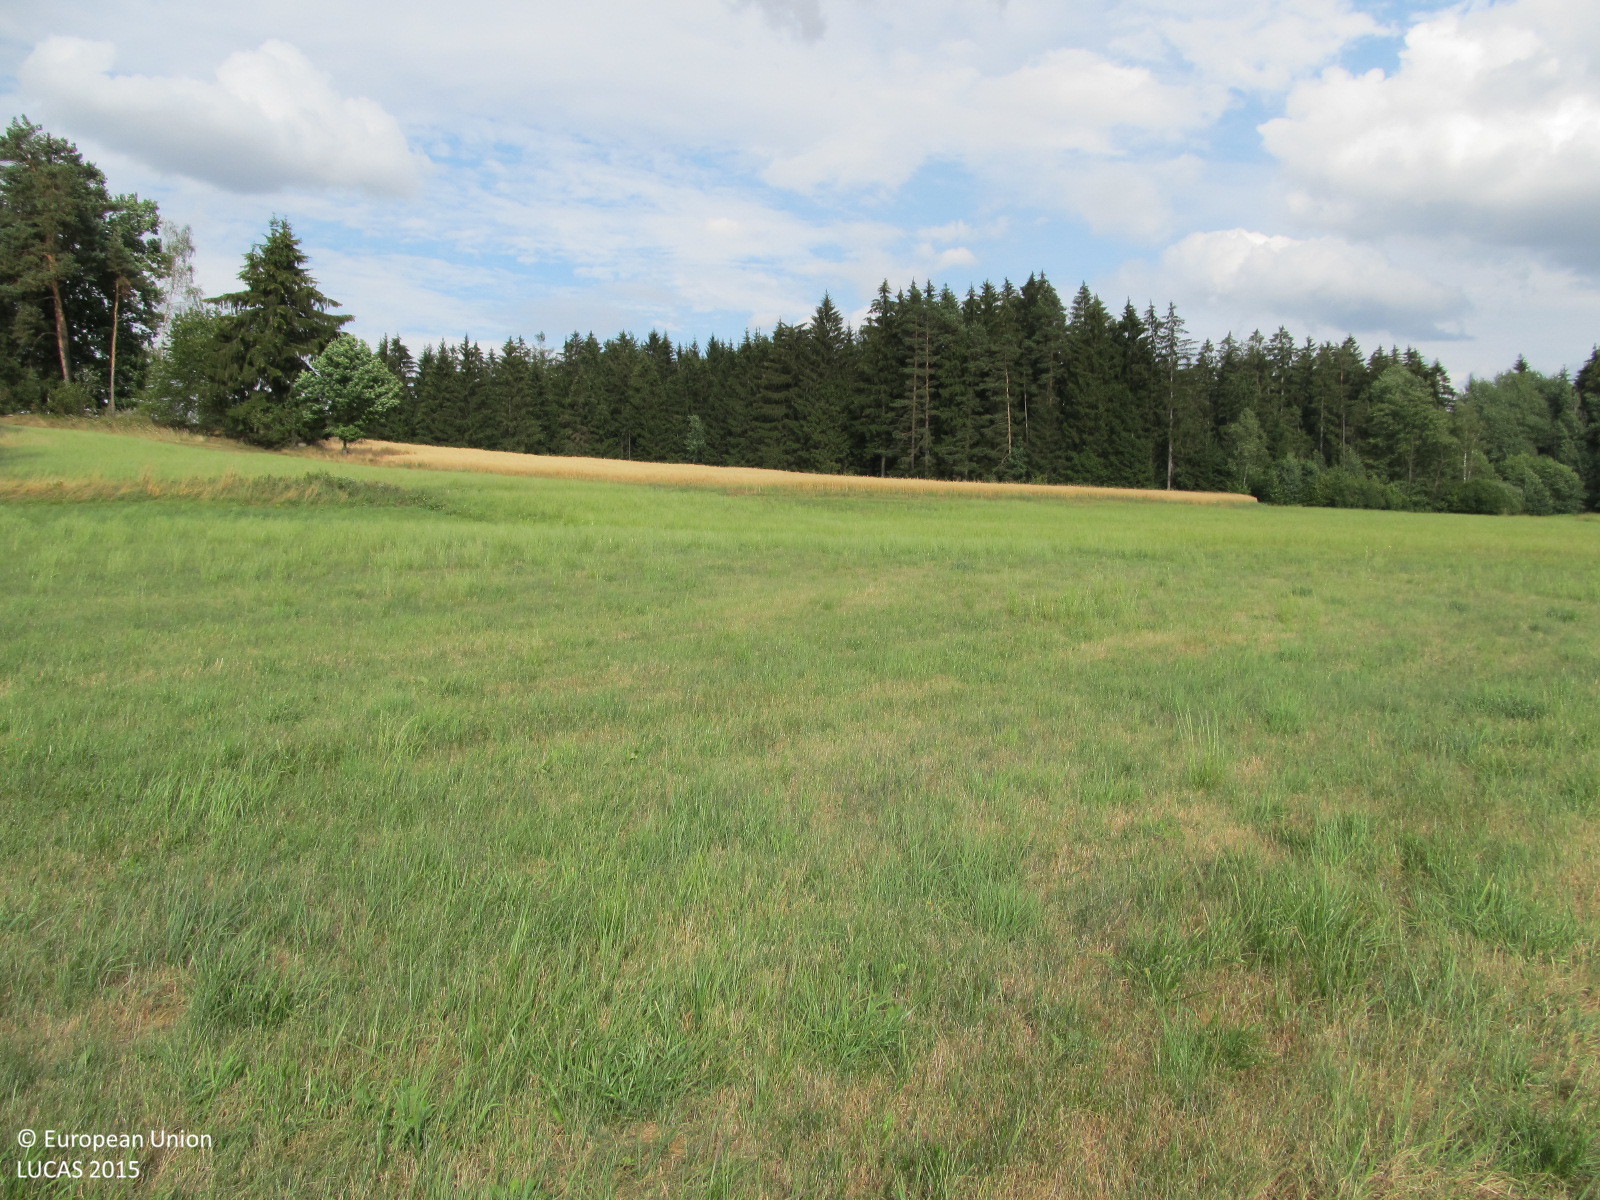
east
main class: Grassland
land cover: Grassland without tree/shrub cover
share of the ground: > 75 %
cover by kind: herbaceous plants 100 %
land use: Agriculture (excluding fallow land and kitchen gardens)
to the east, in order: Grassland without tree/shrub cover; Ditches and canals; Grassland without tree/shrub cover; Tracks; Oats; Grassland without tree/shrub cover; Spruce dominated coniferous woodland; Tracks; Spruce dominated coniferous woodland
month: July
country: AT
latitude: 48.7031
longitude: 15.0431
